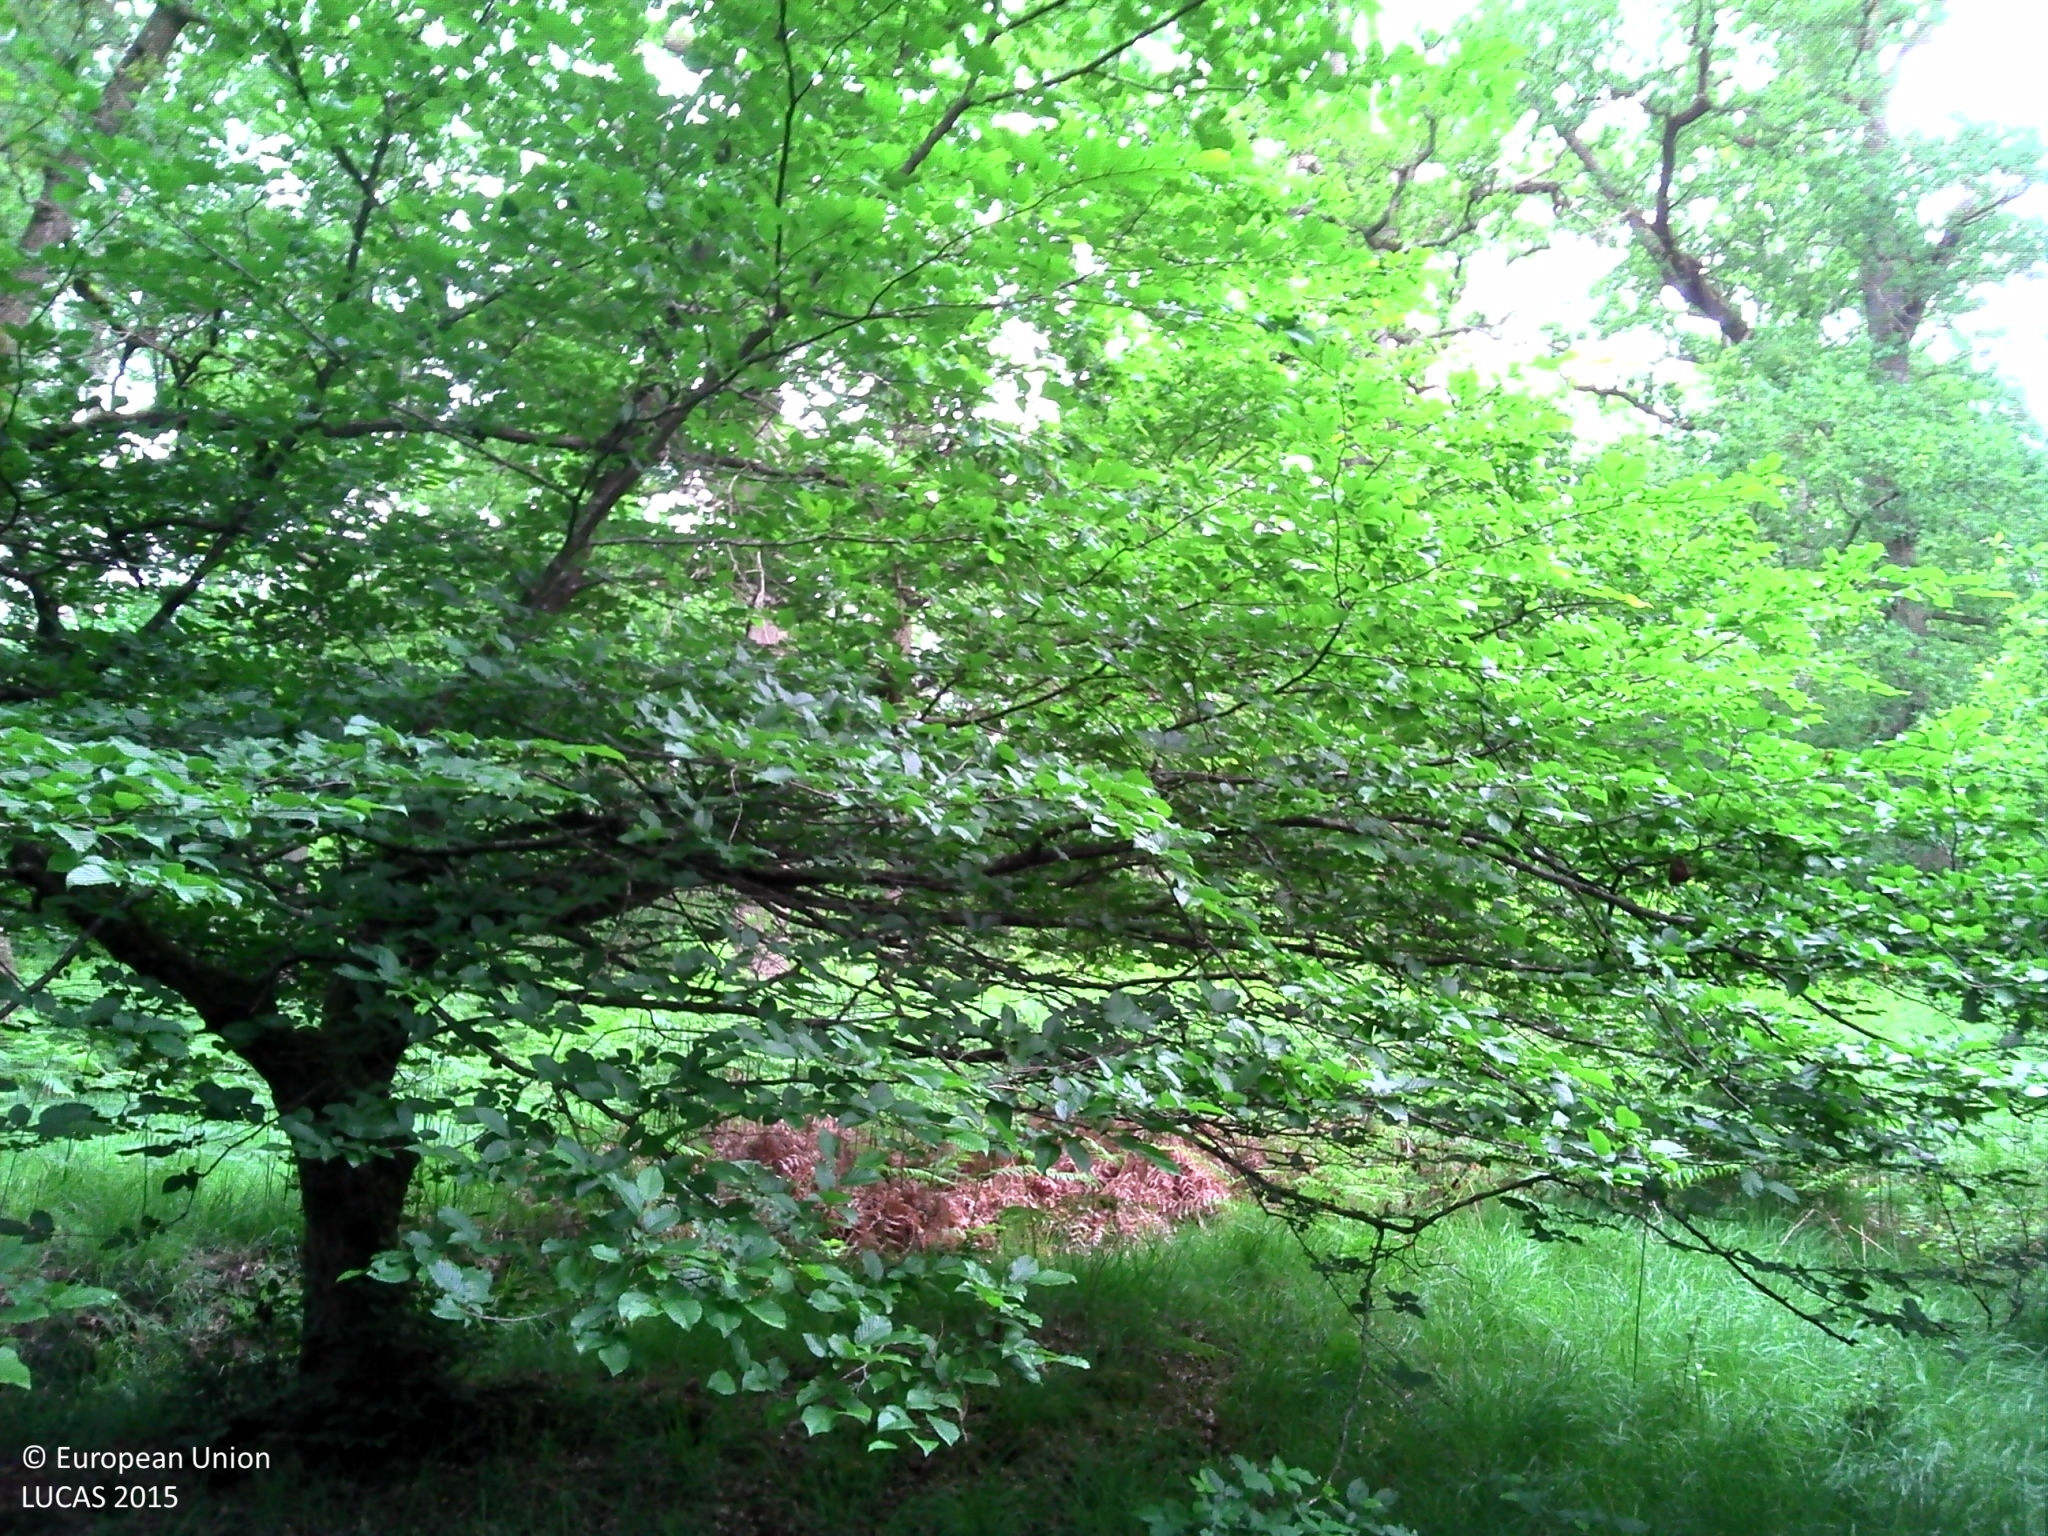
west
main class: Woodland
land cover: Broadleaved woodland
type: acidophilous oak and oak-birch forest
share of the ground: > 75 %
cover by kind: broadleaved forest trees 85 %, herbaceous plants 15 %
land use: Forestry
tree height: > 5 m
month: June
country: FR
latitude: 49.3848
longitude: 2.8958
